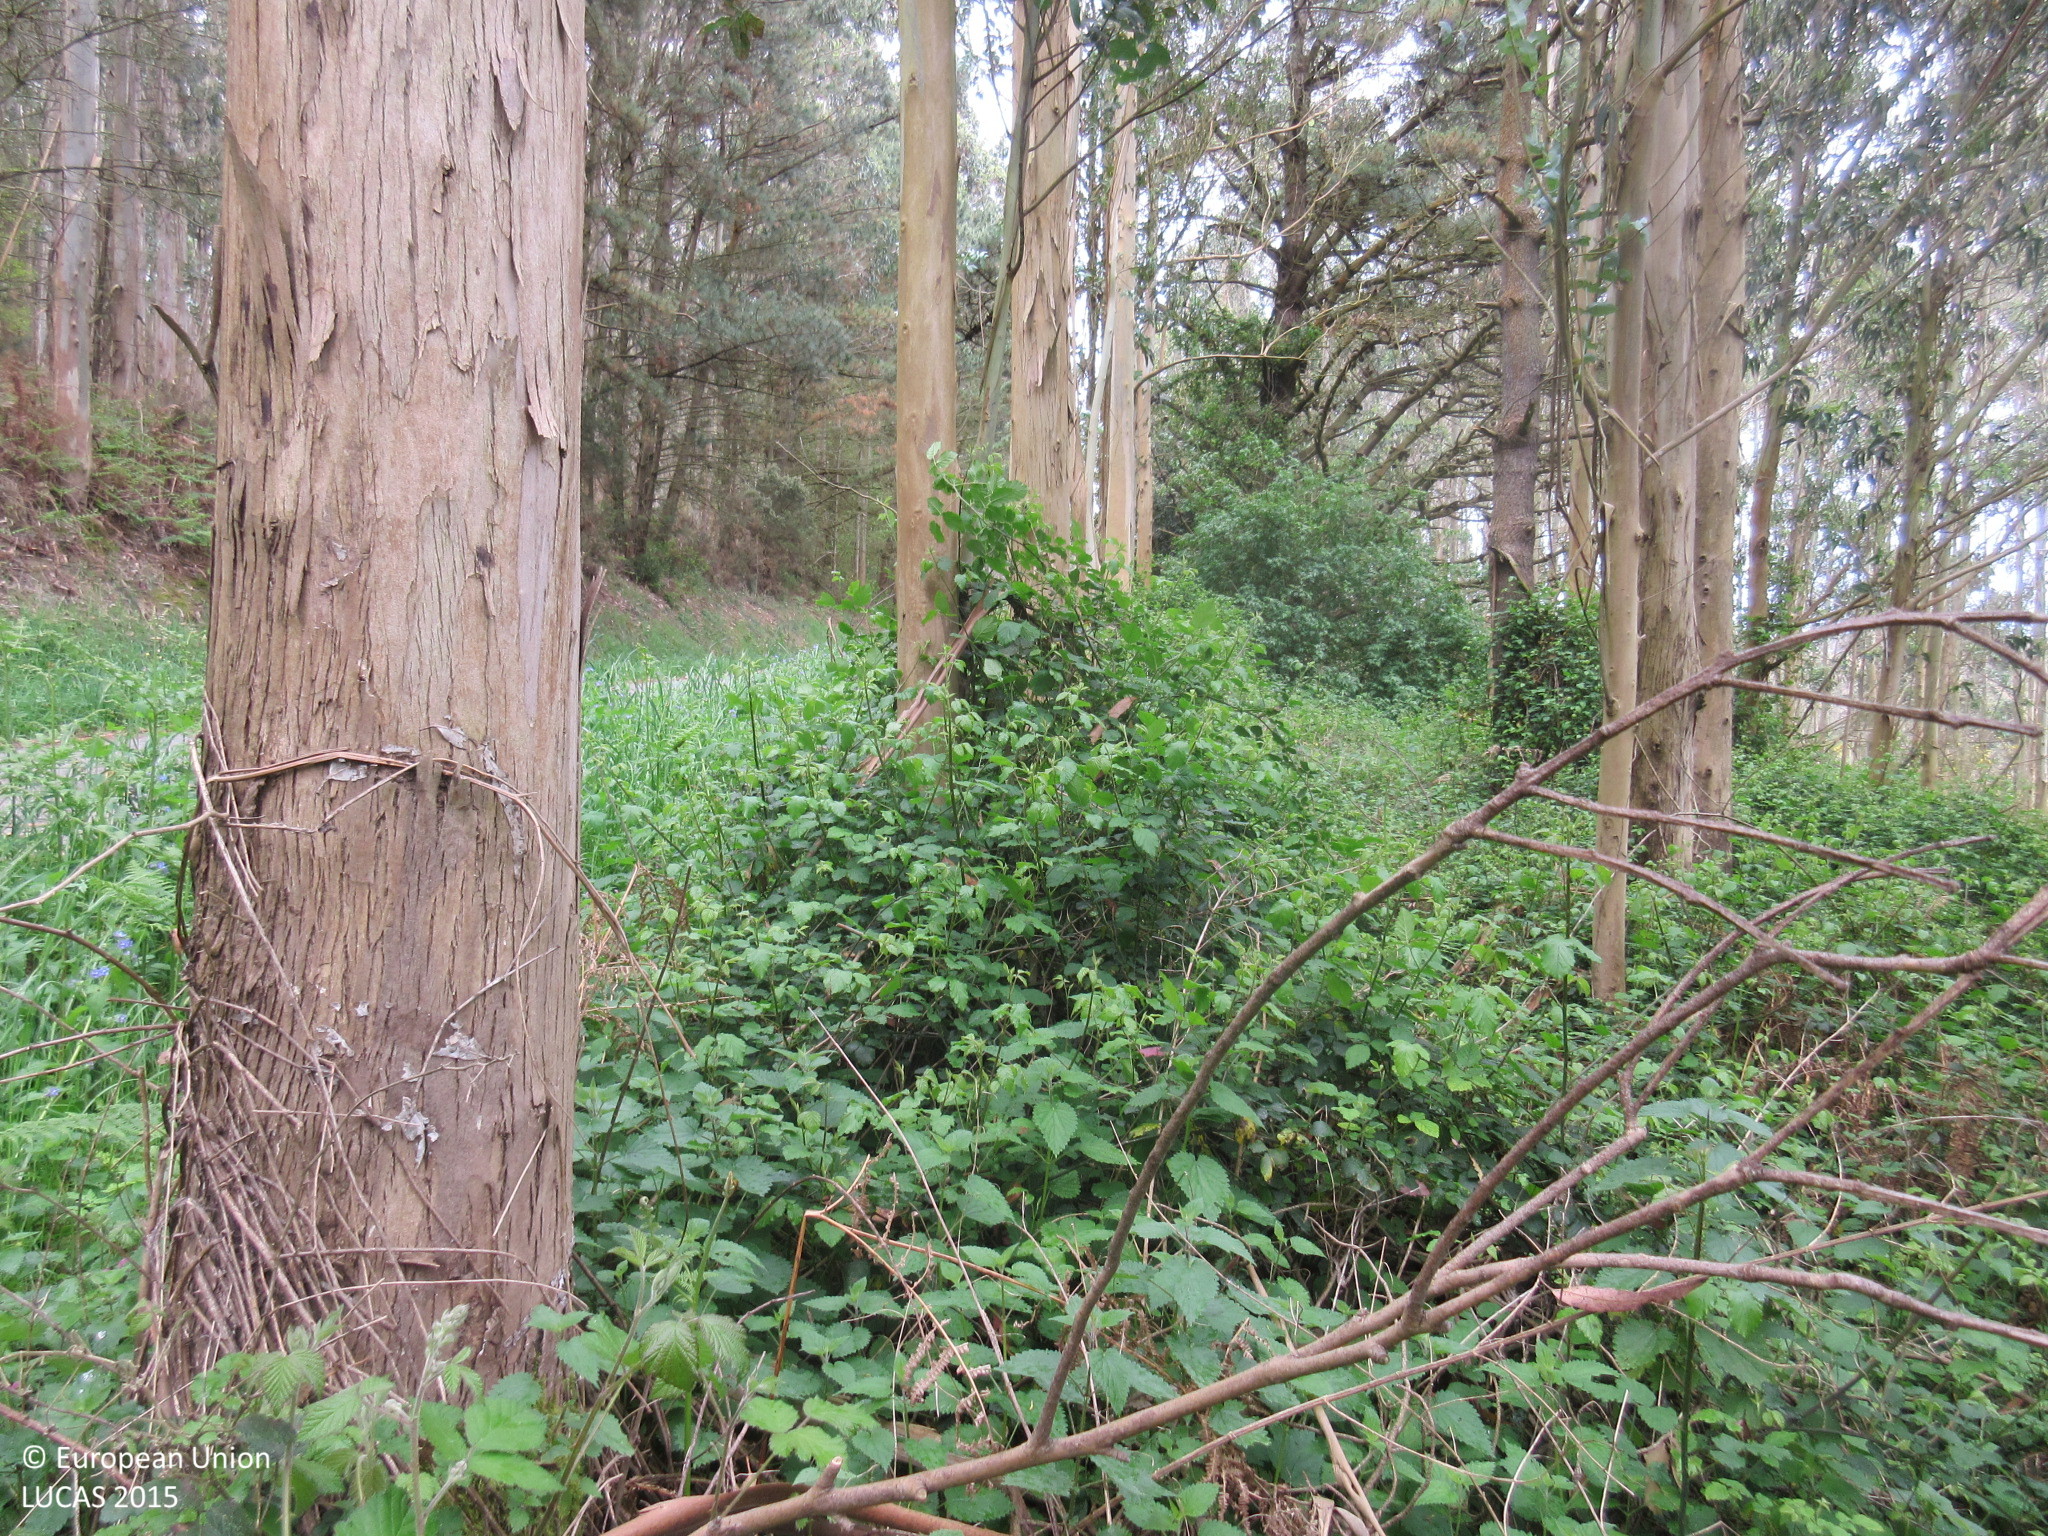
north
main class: Woodland
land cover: Broadleaved woodland
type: exotic forest
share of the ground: > 75 %
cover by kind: broadleaved forest trees 95 %, shrubs 5 %
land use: Forestry
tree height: > 5 m
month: April
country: ES
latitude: 43.4770
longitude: -7.1699
